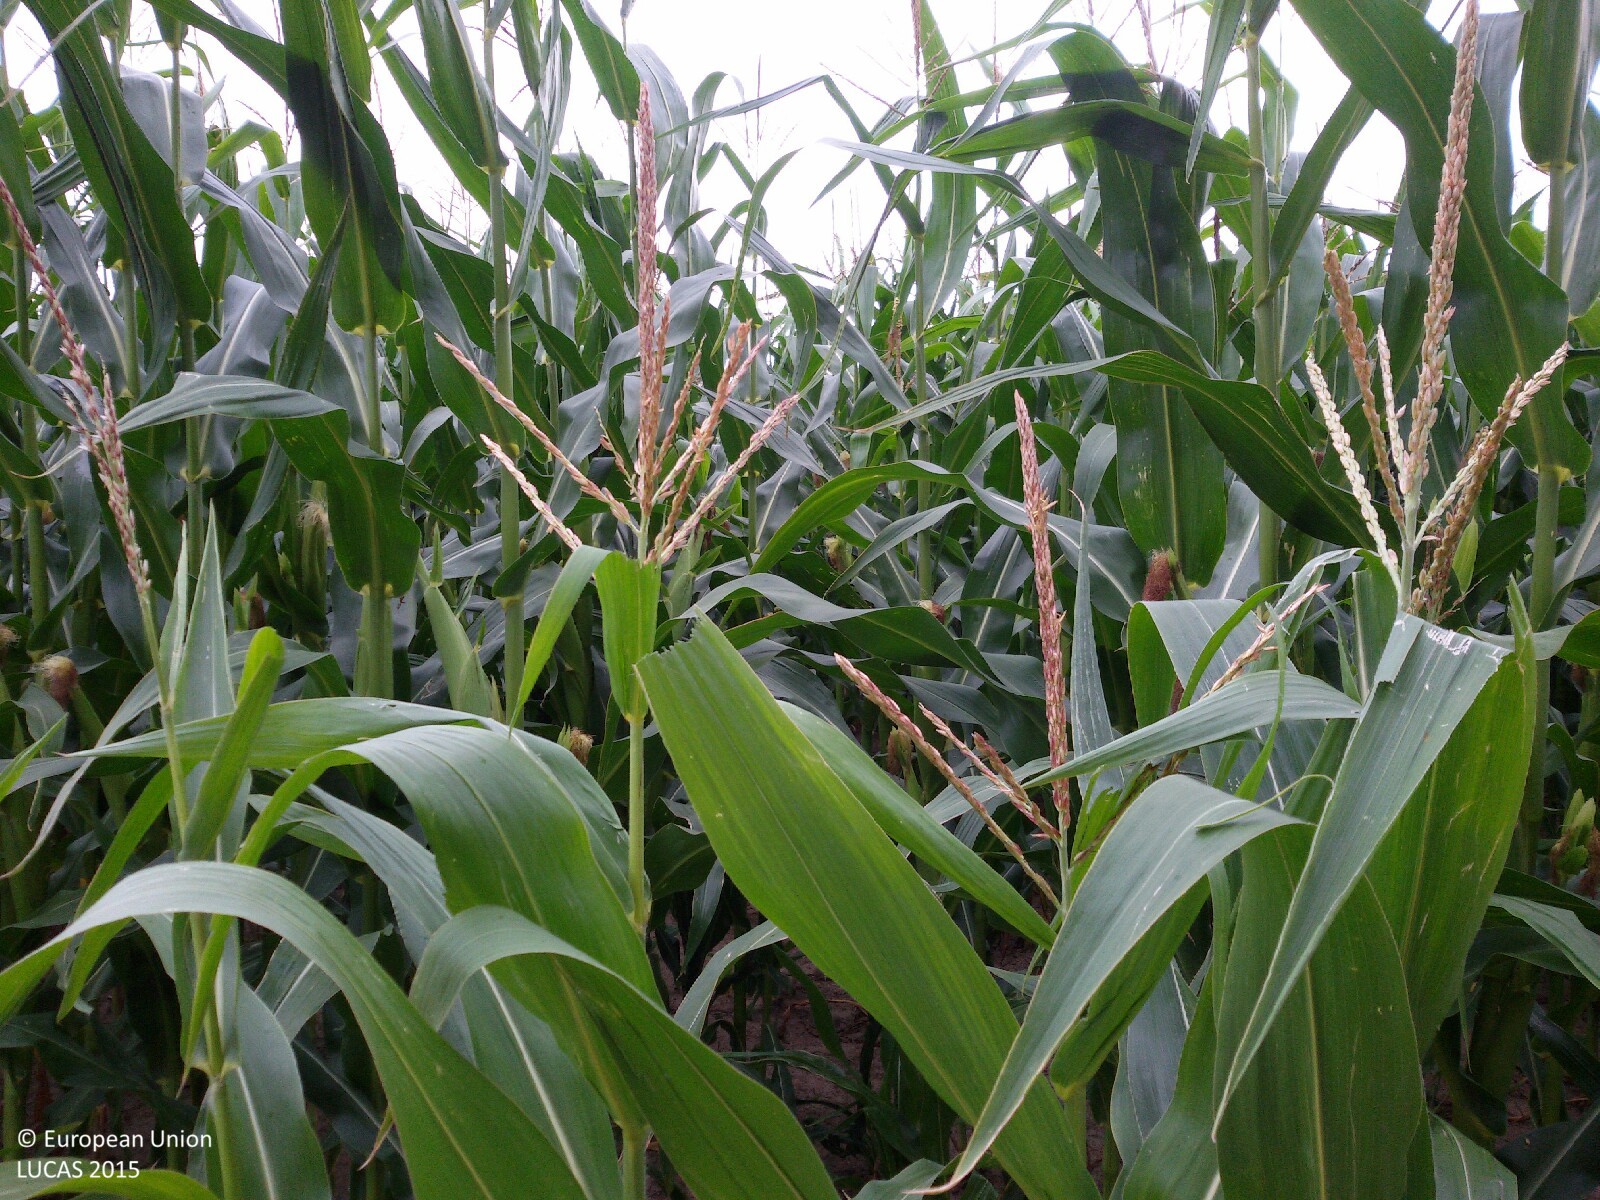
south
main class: Cropland
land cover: Maize
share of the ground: > 75 %
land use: Agriculture (excluding fallow land and kitchen gardens)
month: July
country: PL
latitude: 51.8499
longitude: 21.7115
